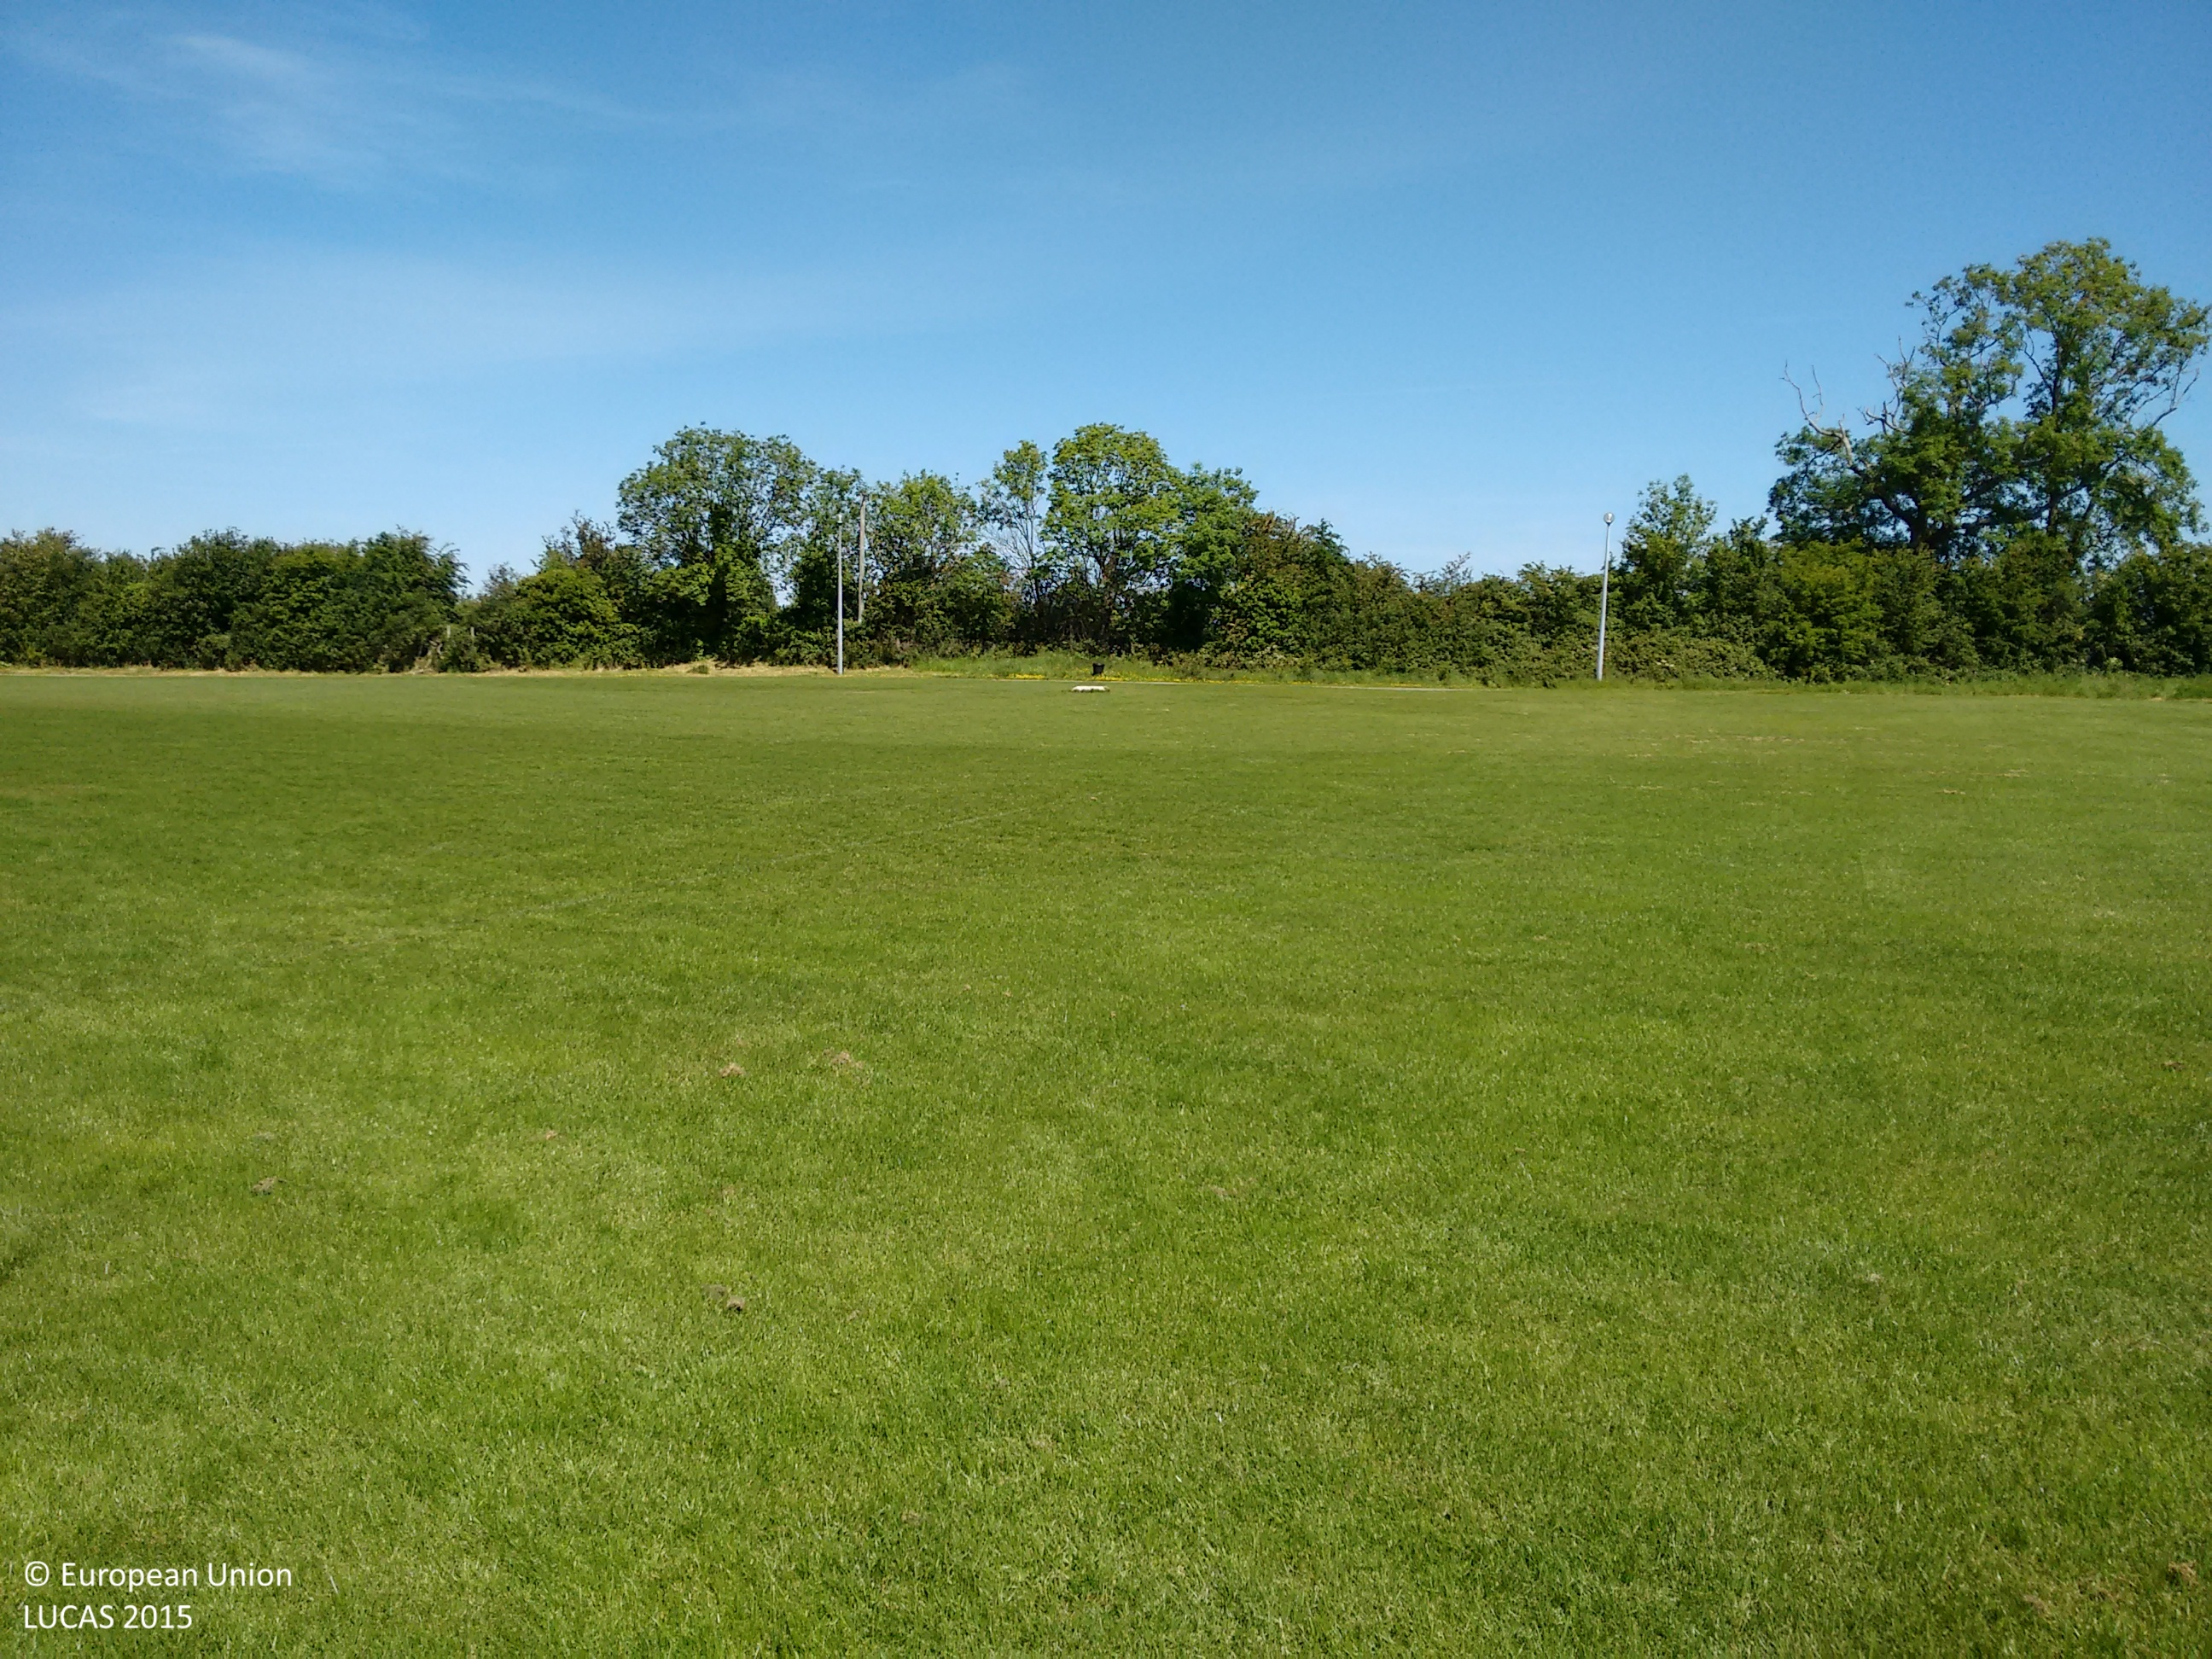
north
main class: Grassland
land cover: Grassland without tree/shrub cover
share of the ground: > 75 %
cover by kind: herbaceous plants 100 %
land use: Sport
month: June
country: IE
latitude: 53.4725
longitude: -6.2239
